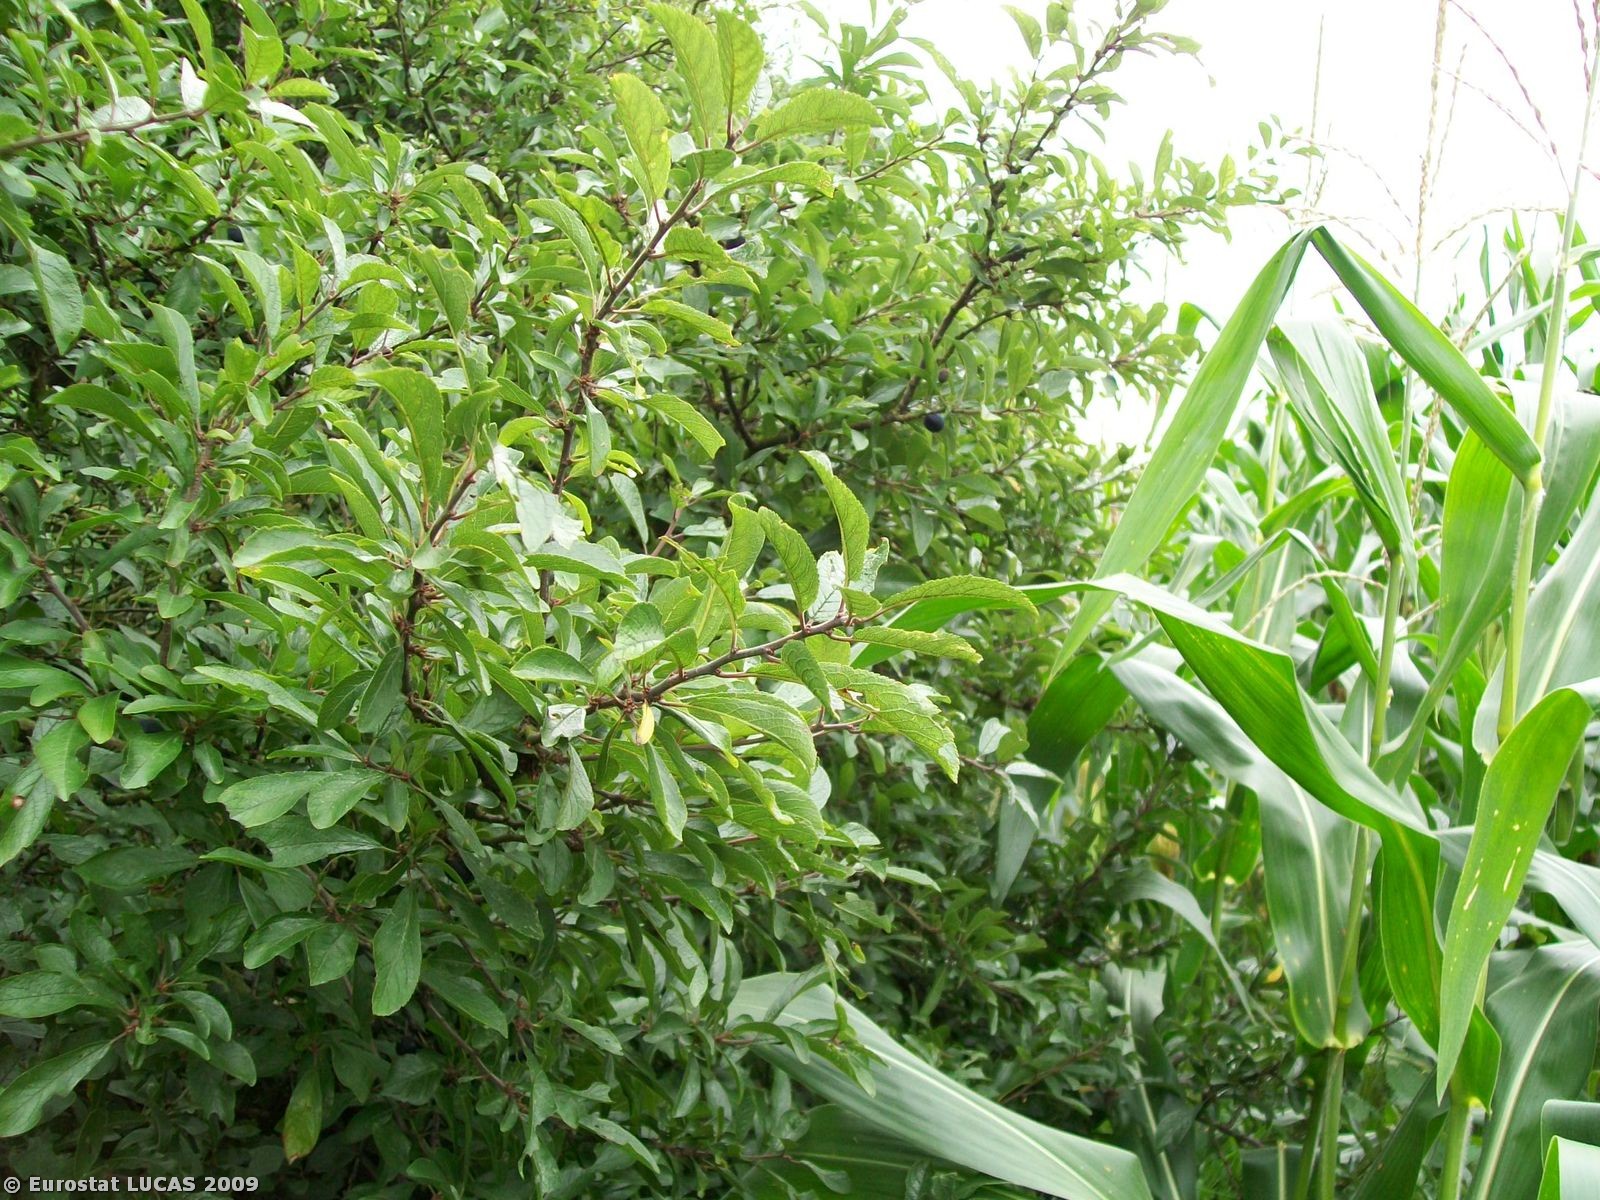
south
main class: Cropland
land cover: Maize
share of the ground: > 75 %
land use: Agriculture (excluding fallow land and kitchen gardens)
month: August
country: PL
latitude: 51.0903
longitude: 16.9631
